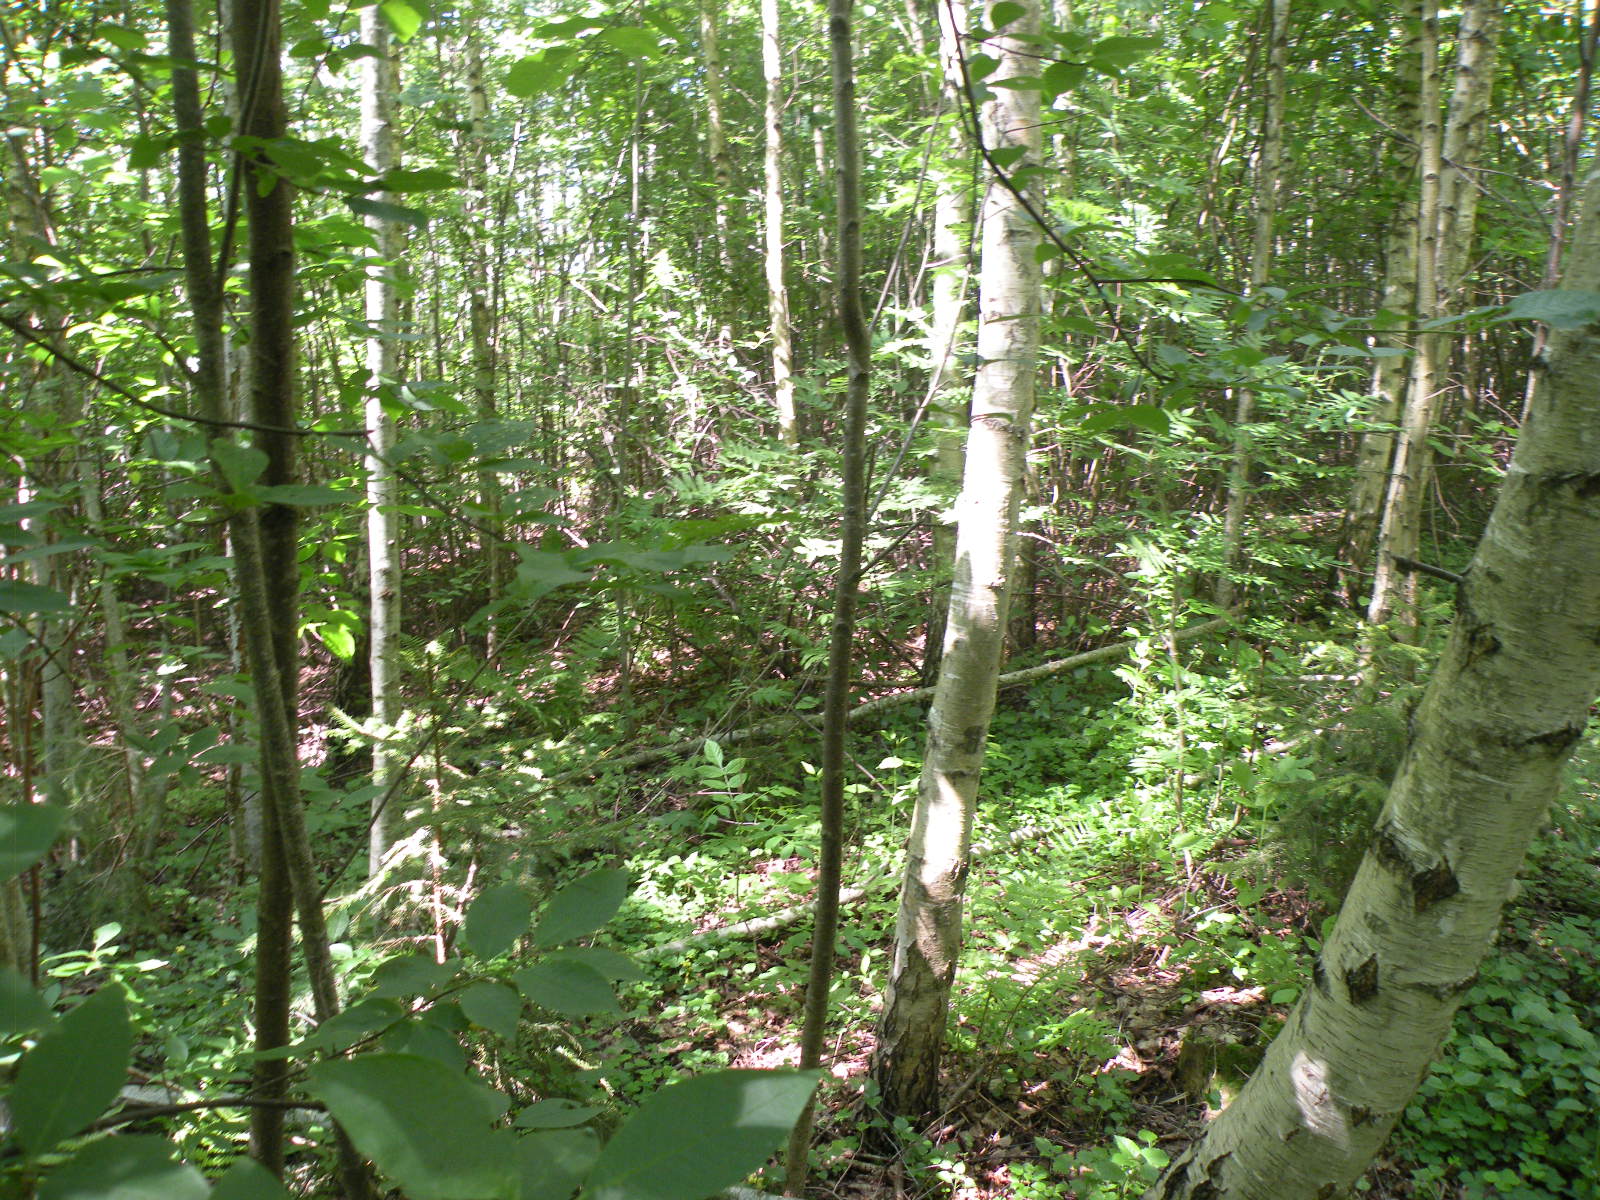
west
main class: Woodland
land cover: Broadleaved woodland
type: non-riverine alder, birch or aspen forest
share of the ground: > 75 %
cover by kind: broadleaved forest trees 80 %, shrubs 10 %, herbaceous plants 10 %
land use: Forestry
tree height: > 5 m
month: May
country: LV
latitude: 55.9736
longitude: 26.2138
